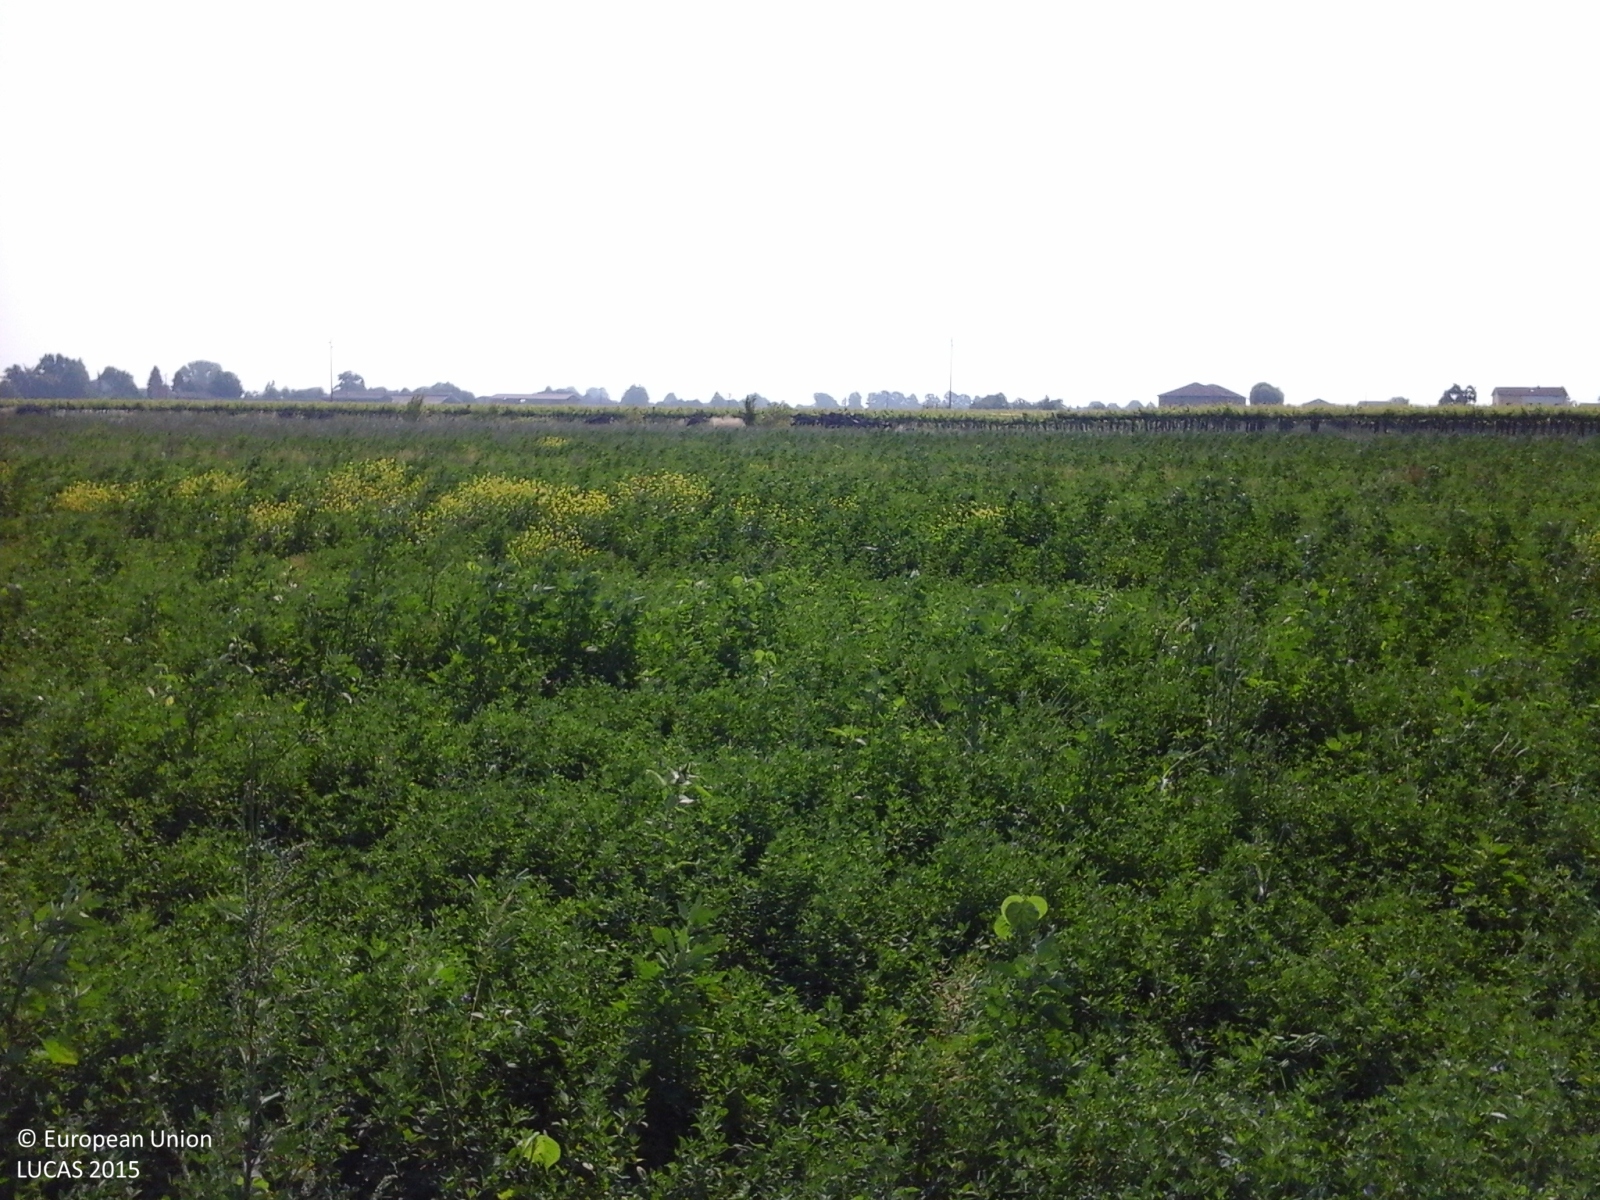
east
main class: Cropland
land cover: Lucerne
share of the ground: > 75 %
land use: Agriculture (excluding fallow land and kitchen gardens)
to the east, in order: Lucerne; Ditches and canals; Lucerne; Tracks; Ditches and canals; Grassland without tree/shrub cover; Tracks; Vineyards
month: May
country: IT
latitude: 44.7082
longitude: 10.7935
